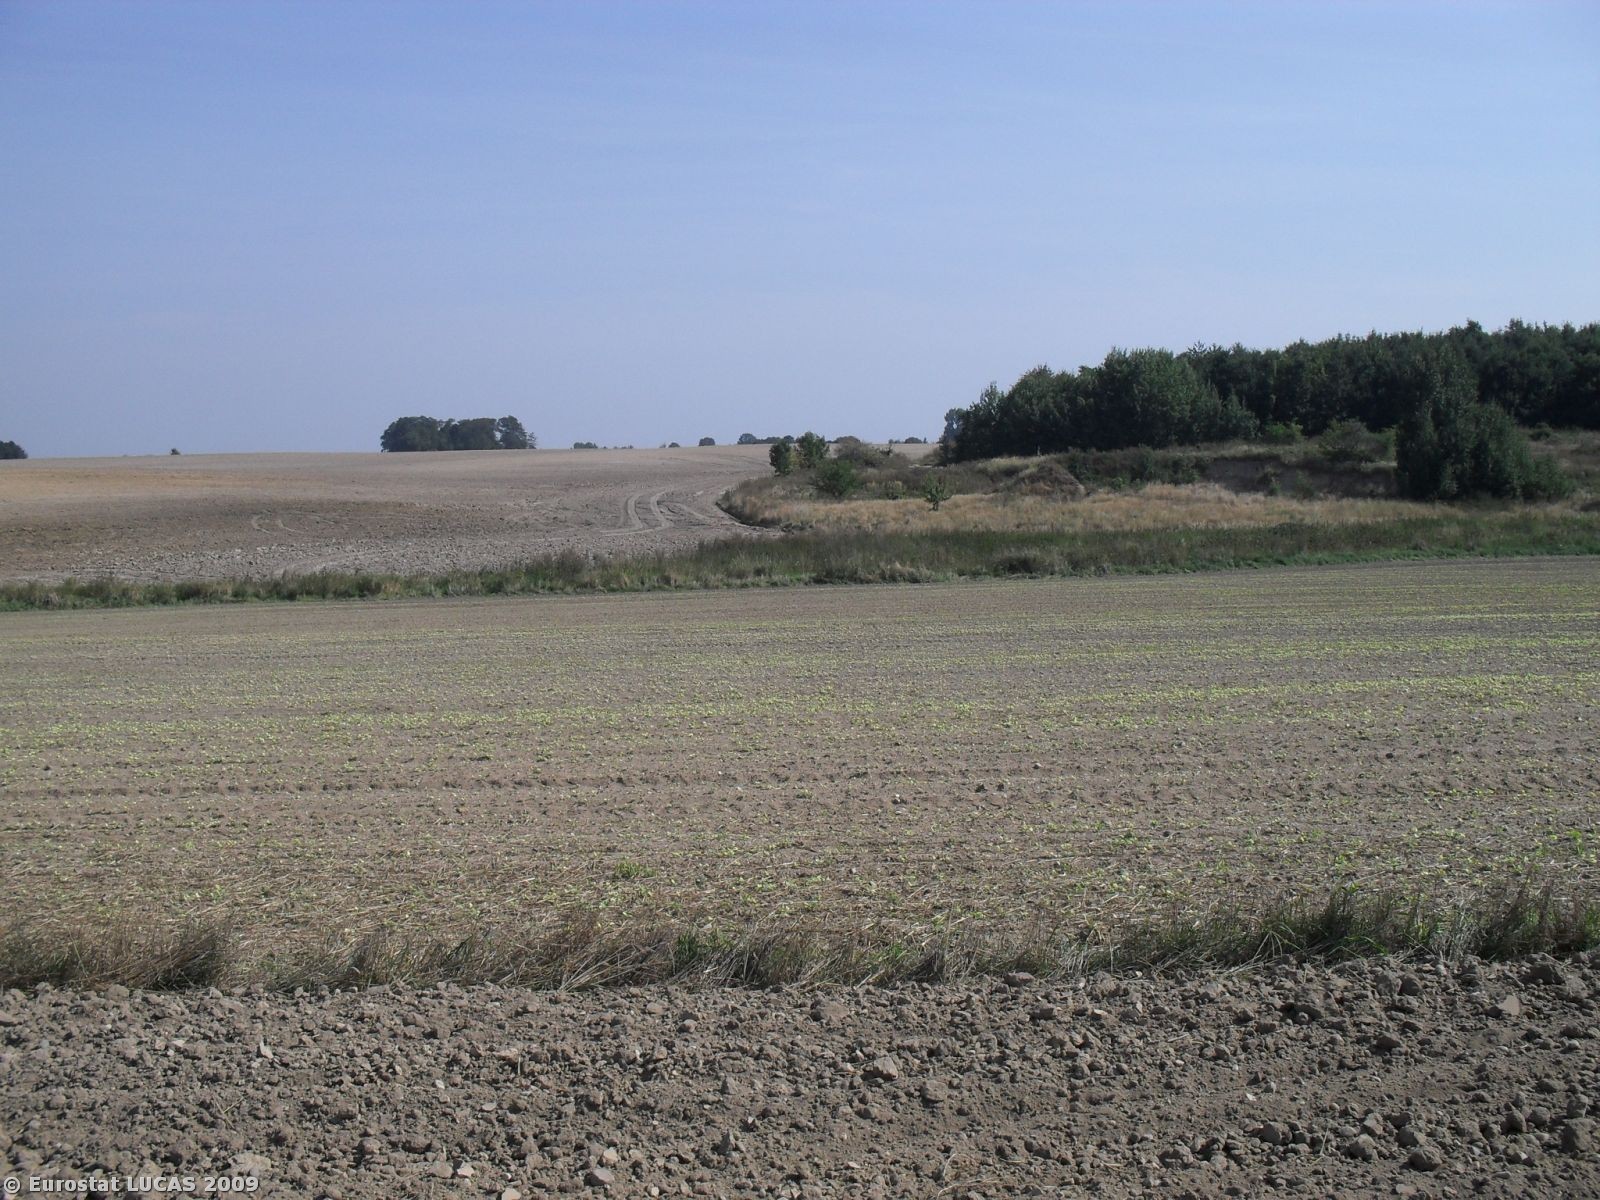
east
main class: Cropland
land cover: Barley
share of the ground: < 10 %
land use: Agriculture (excluding fallow land and kitchen gardens)
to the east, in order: Barley; Common wheat; Spontaneously vegetated surfaces; Rivers and streams; Spontaneously vegetated surfaces; Rape and turnip rape
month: September
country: PL
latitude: 50.5991
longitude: 17.3158
